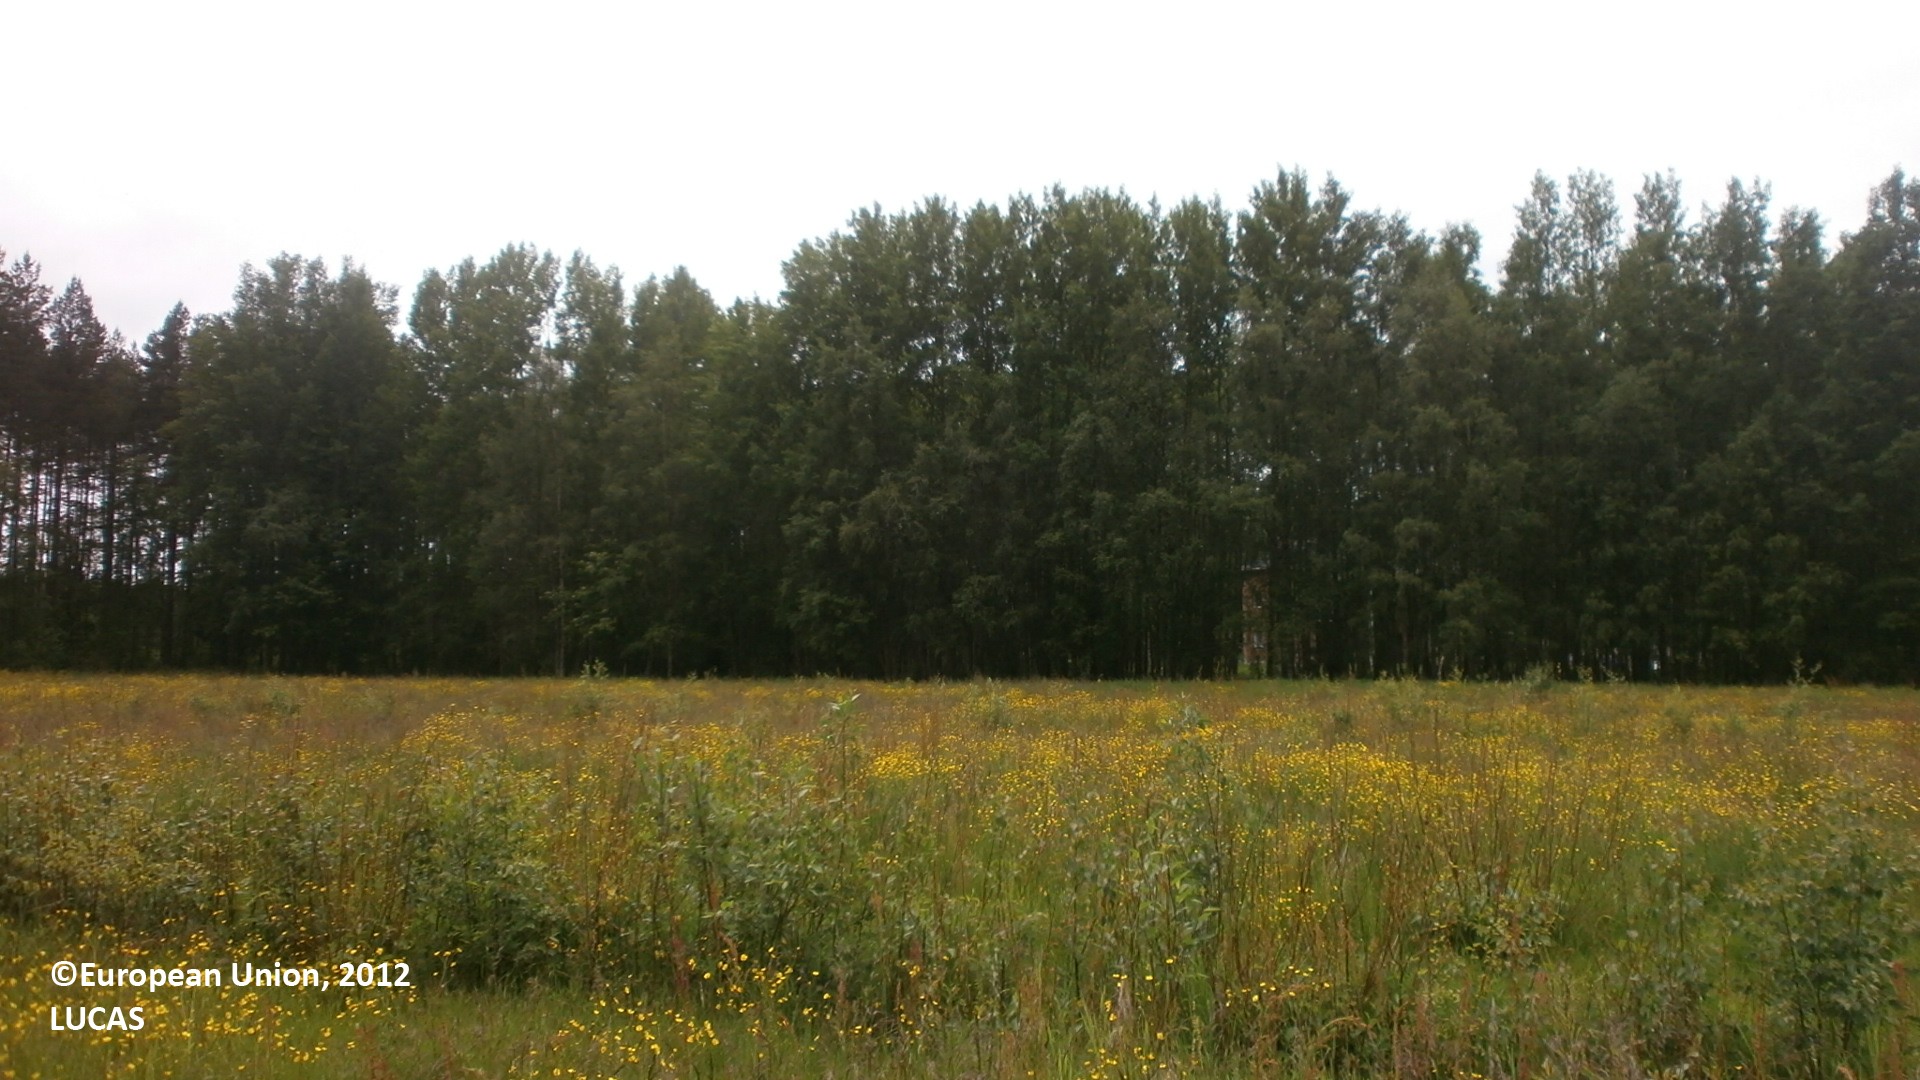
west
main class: Grassland
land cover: Grassland without tree/shrub cover
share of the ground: > 75 %
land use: Agriculture (excluding fallow land and kitchen gardens)
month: June
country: FI
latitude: 64.8133
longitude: 25.3082
